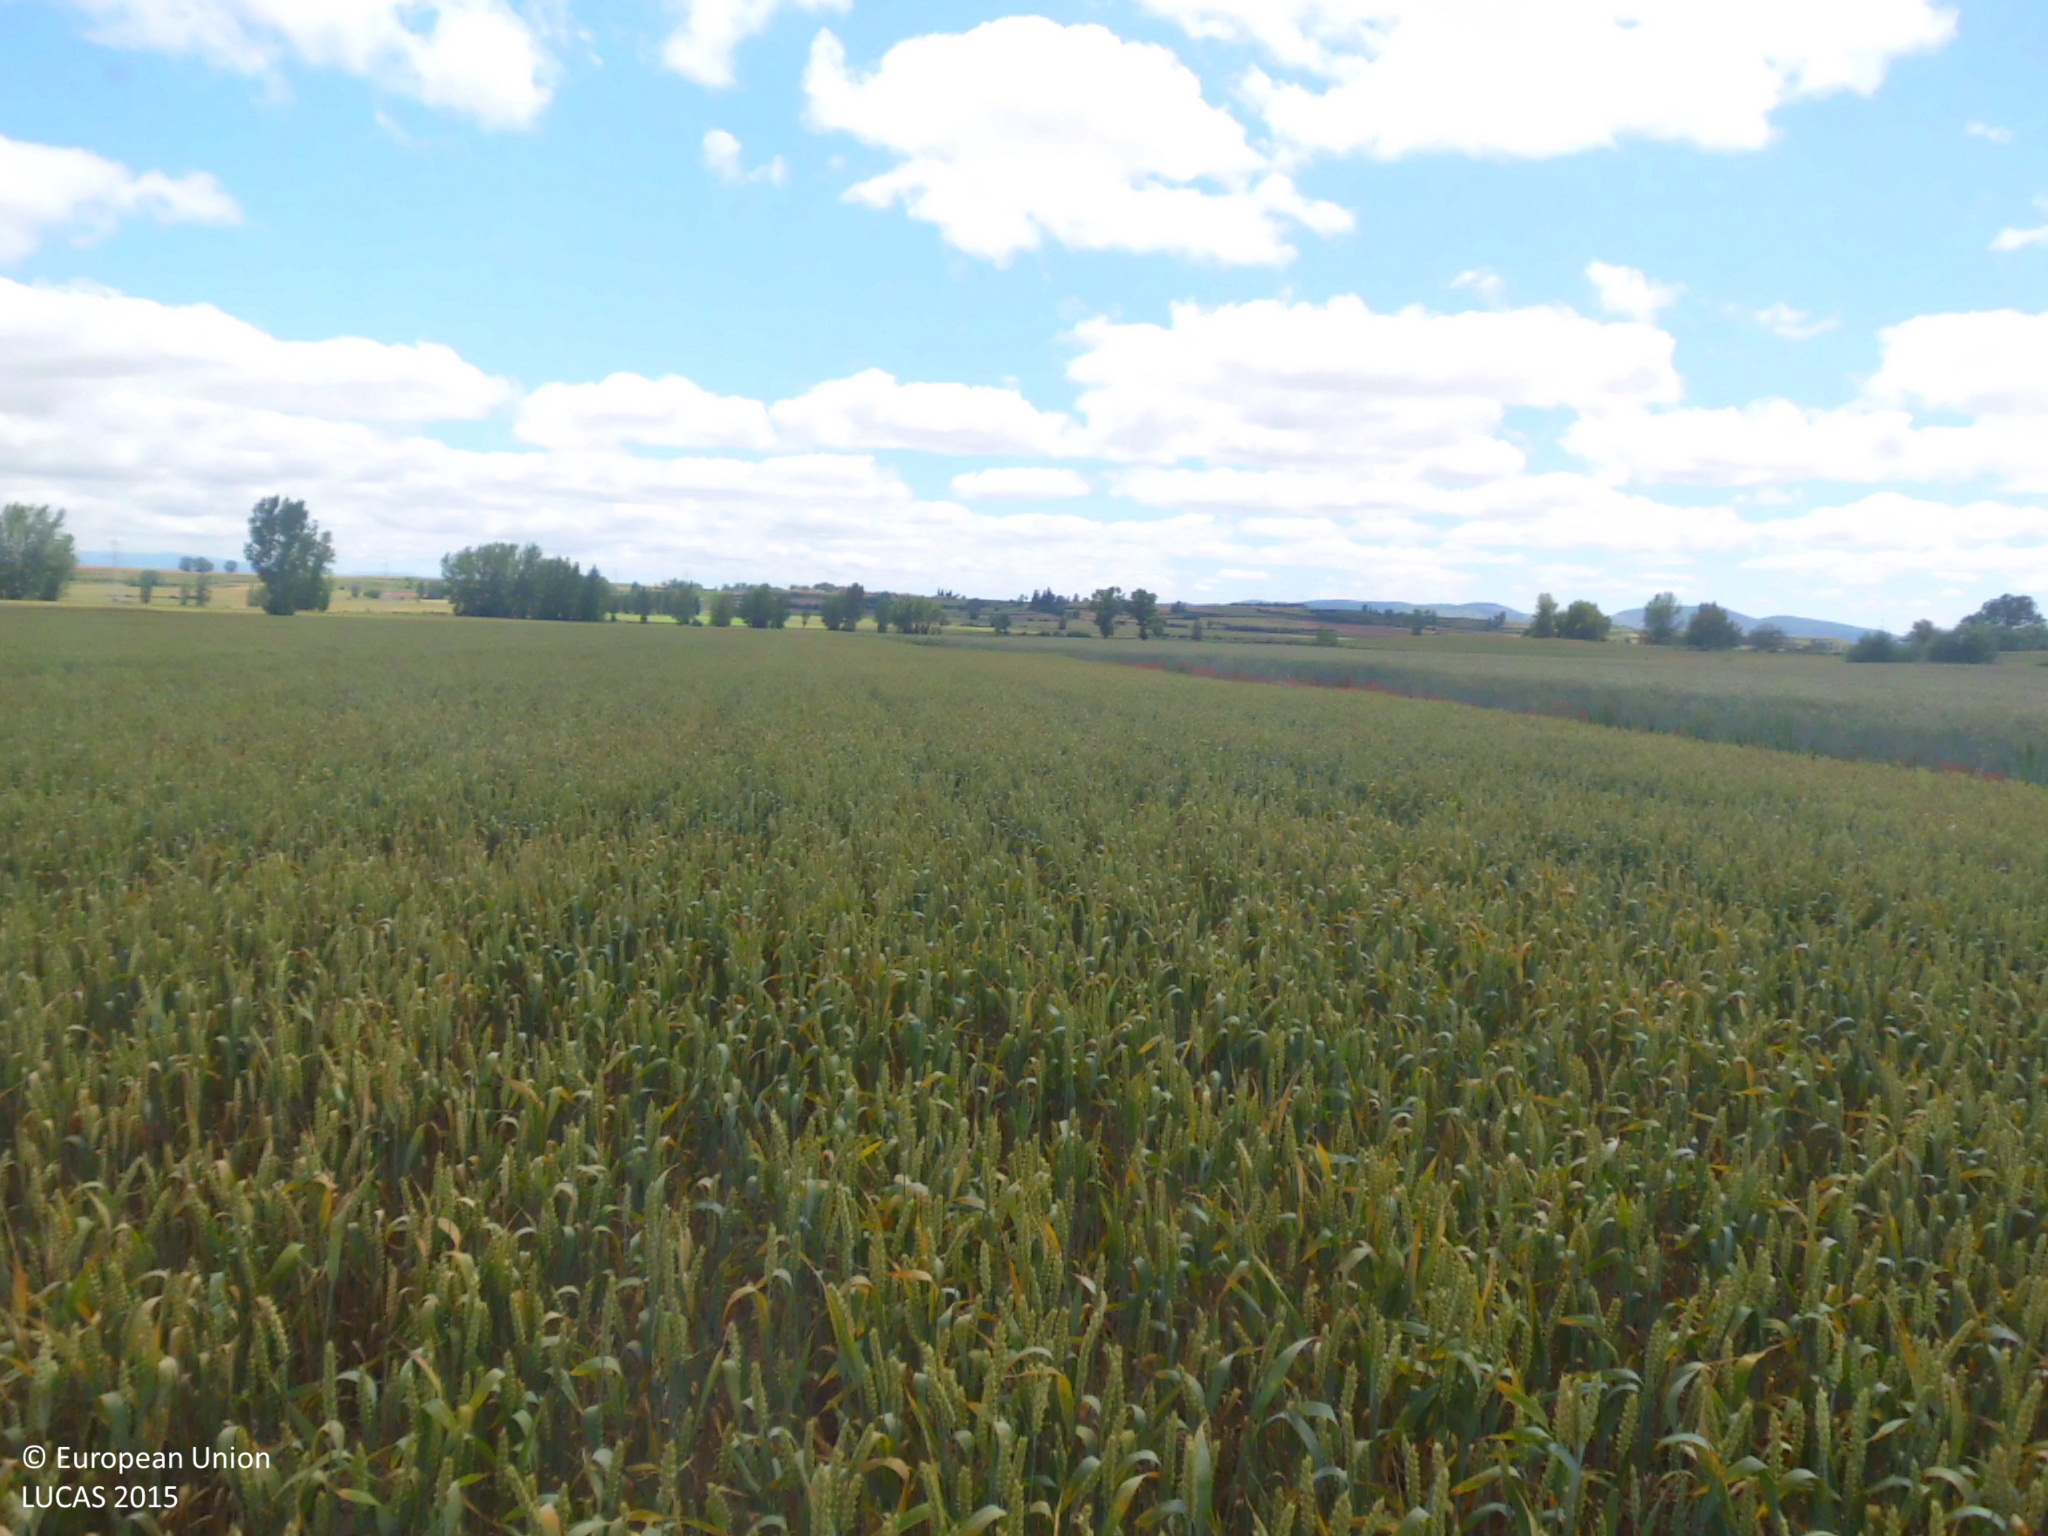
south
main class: Cropland
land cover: Common wheat
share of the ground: > 75 %
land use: Agriculture (excluding fallow land and kitchen gardens)
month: June
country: ES
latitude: 42.6508
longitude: -3.2925
